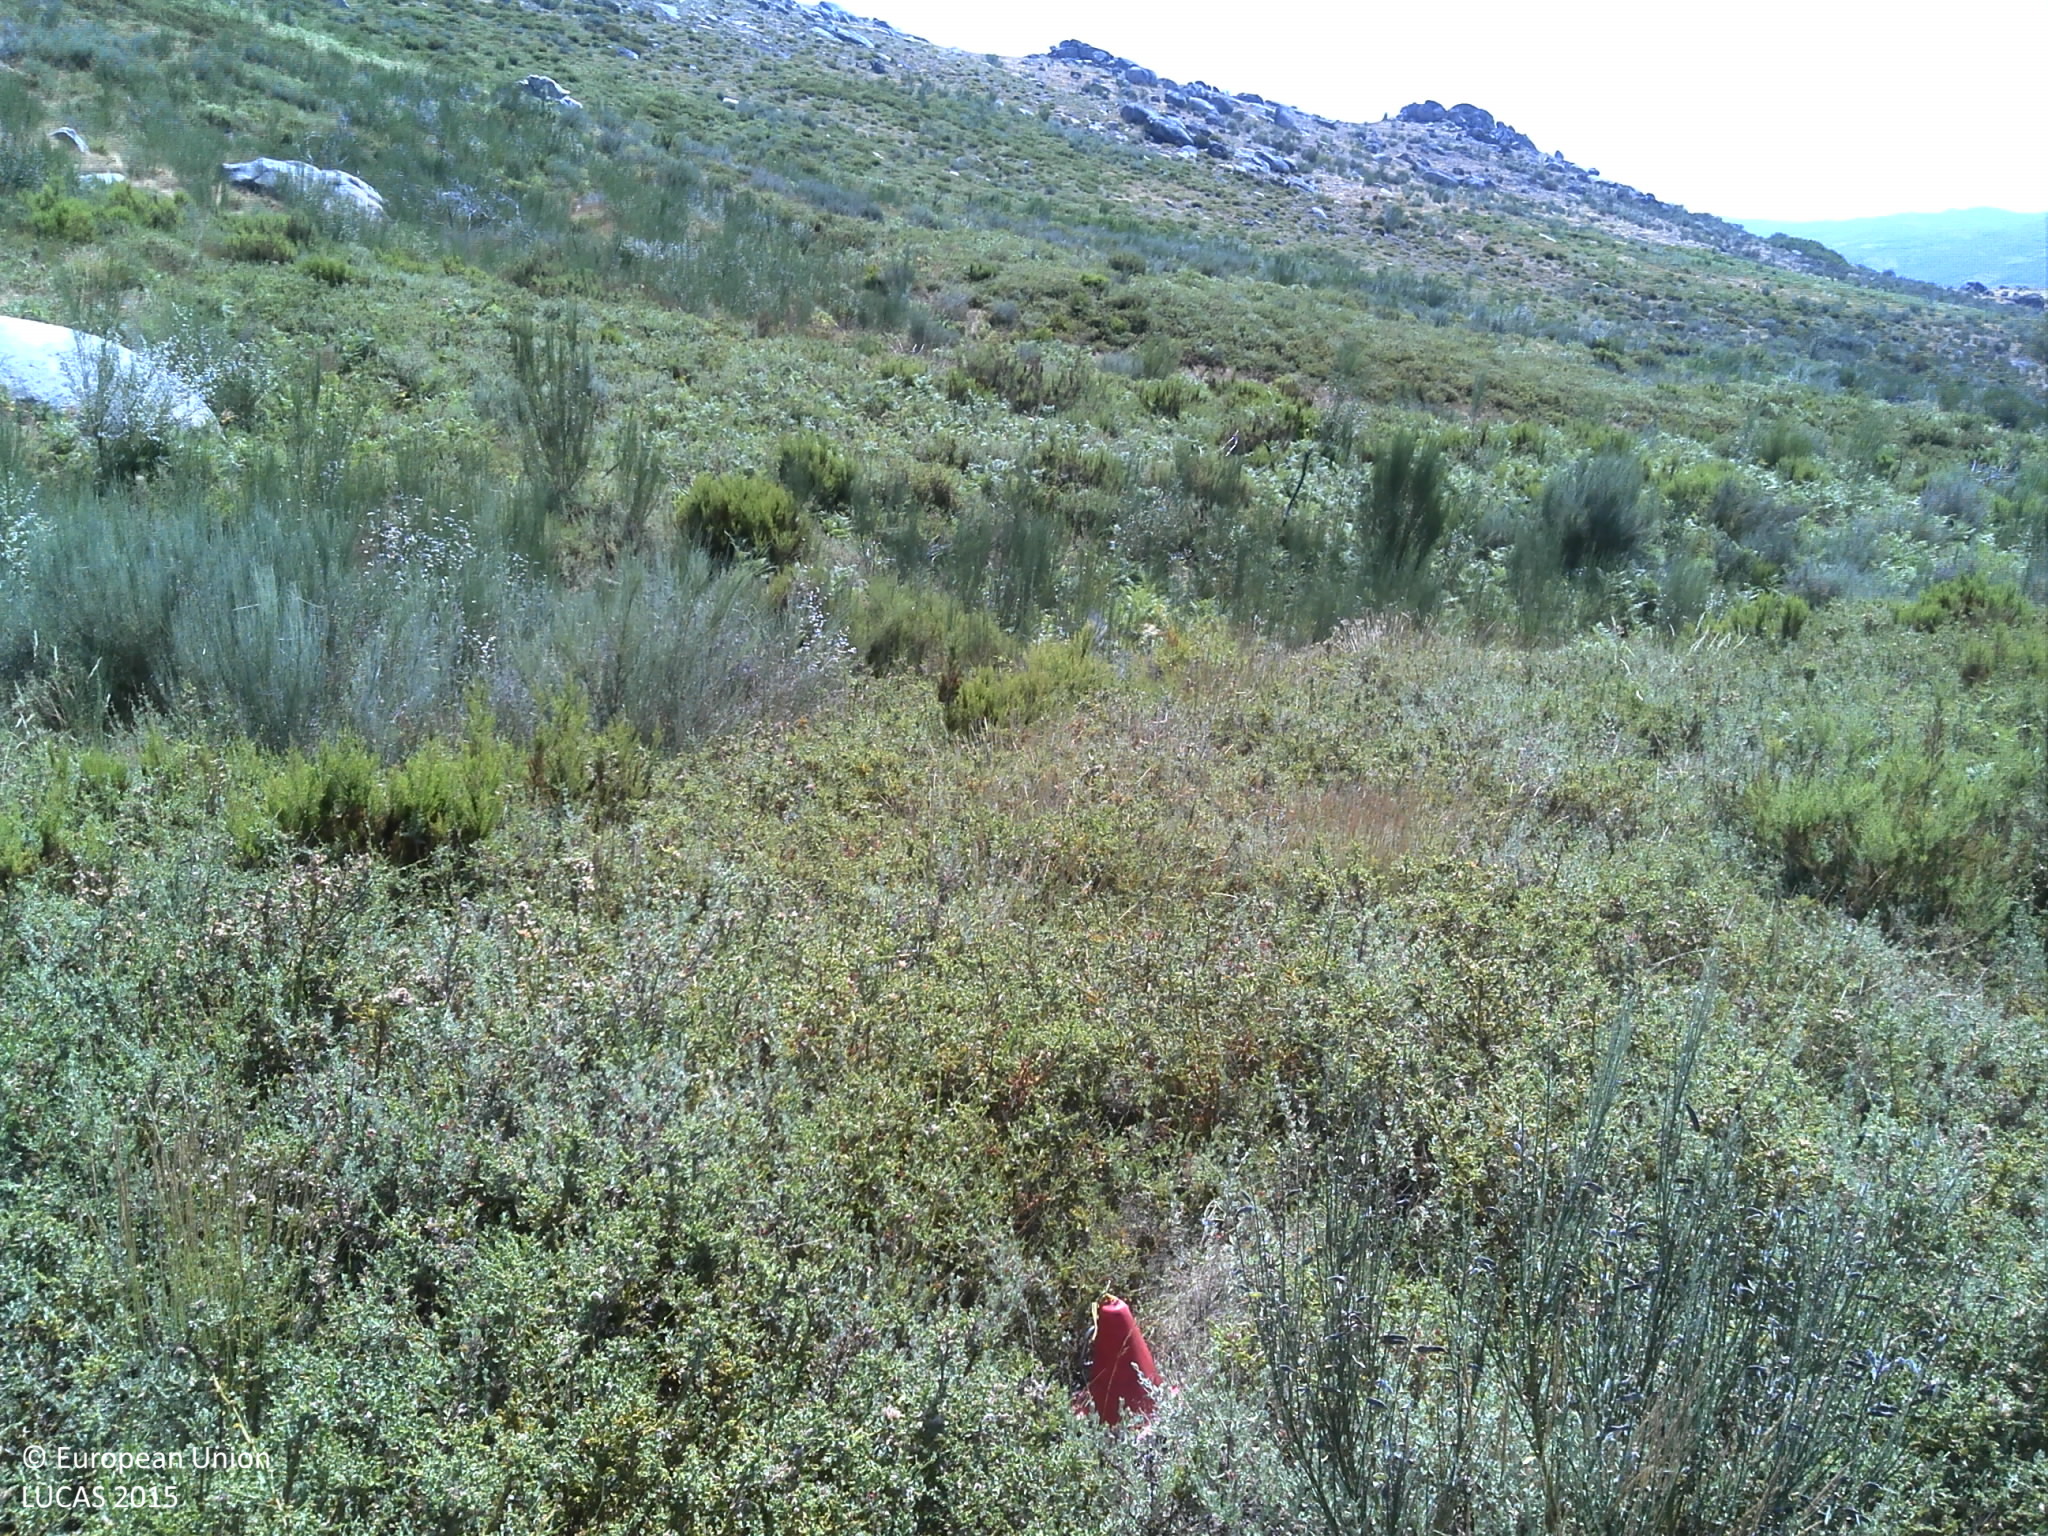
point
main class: Shrubland
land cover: Shrubland without tree cover
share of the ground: > 75 %
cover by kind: shrubs 90 %, herbaceous plants 10 %
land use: Semi-natural and natural areas not in use
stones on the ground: 10 - 25 %
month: July
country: PT
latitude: 41.8705
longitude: -7.7174
